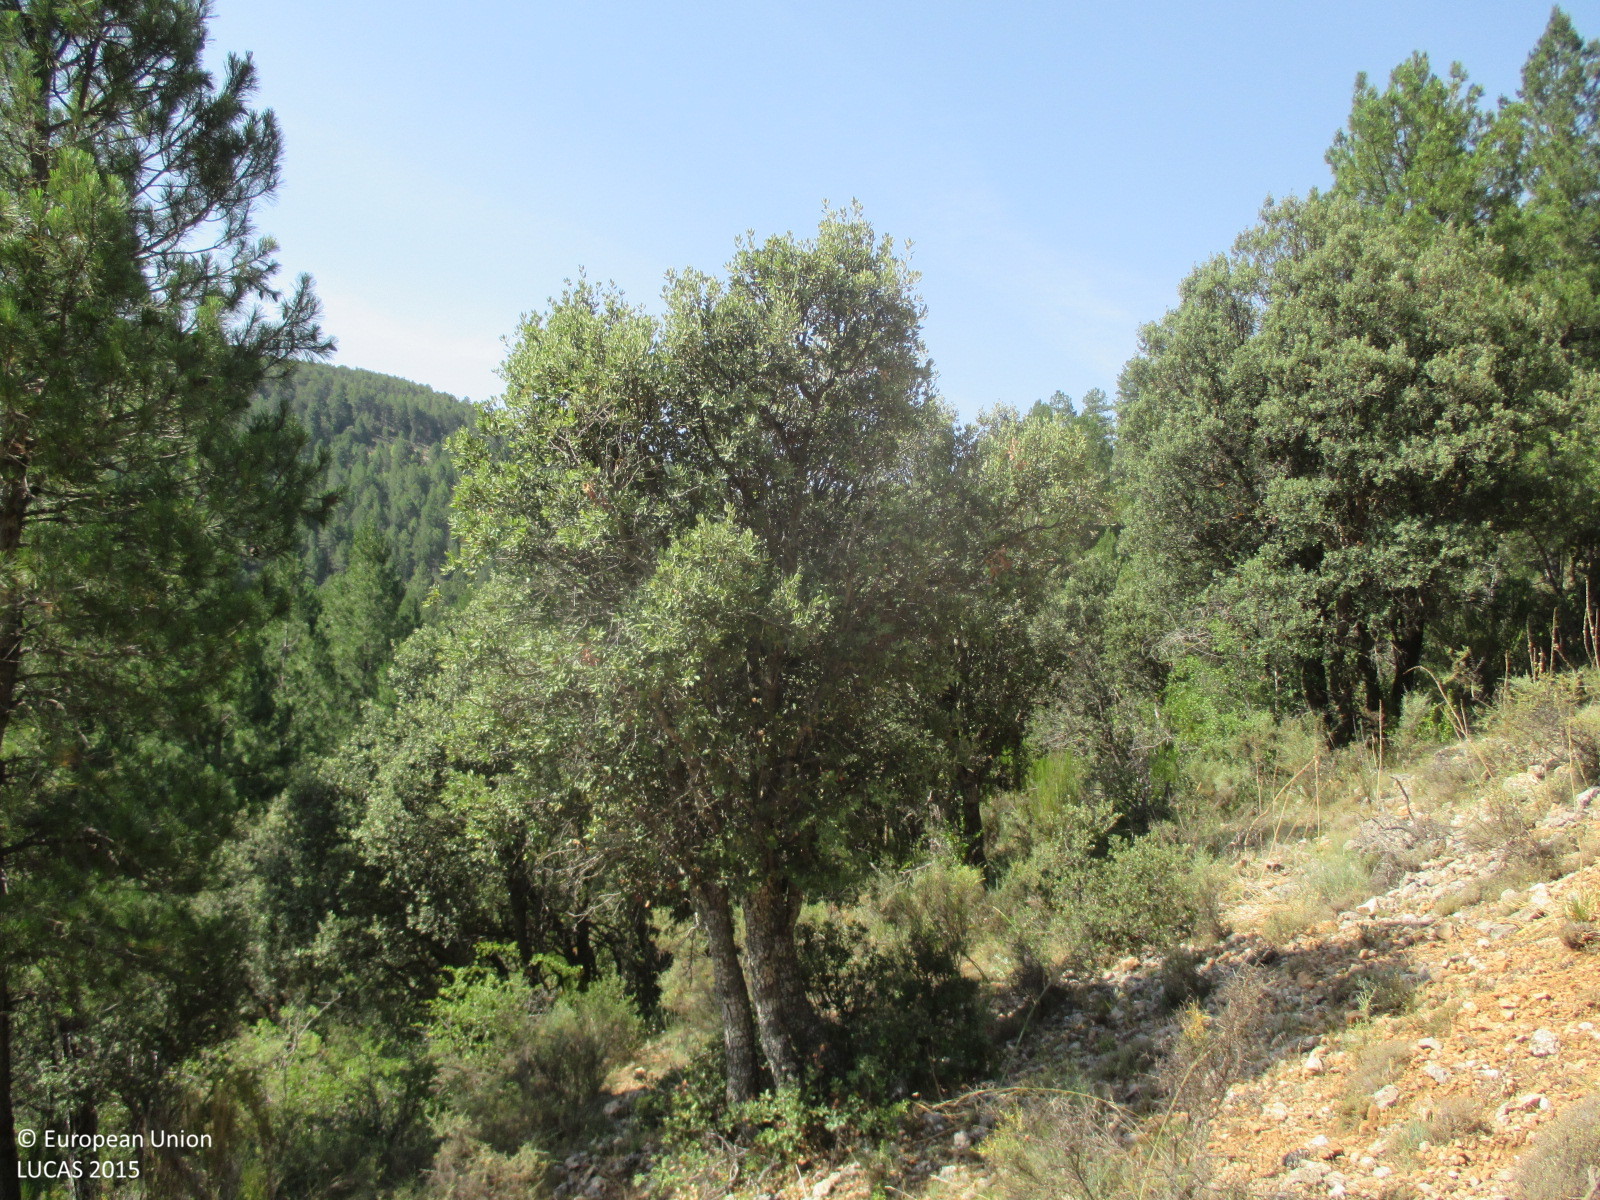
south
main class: Woodland
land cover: Pine dominated mixed woodland
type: alpine coniferous forest
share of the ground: > 75 %
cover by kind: coniferous forest trees 60 %, broadleaved forest trees 30 %, consolidated bare surface 10 %
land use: Forestry
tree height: > 5 m
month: July
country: ES
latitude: 38.1155
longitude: -2.4602
